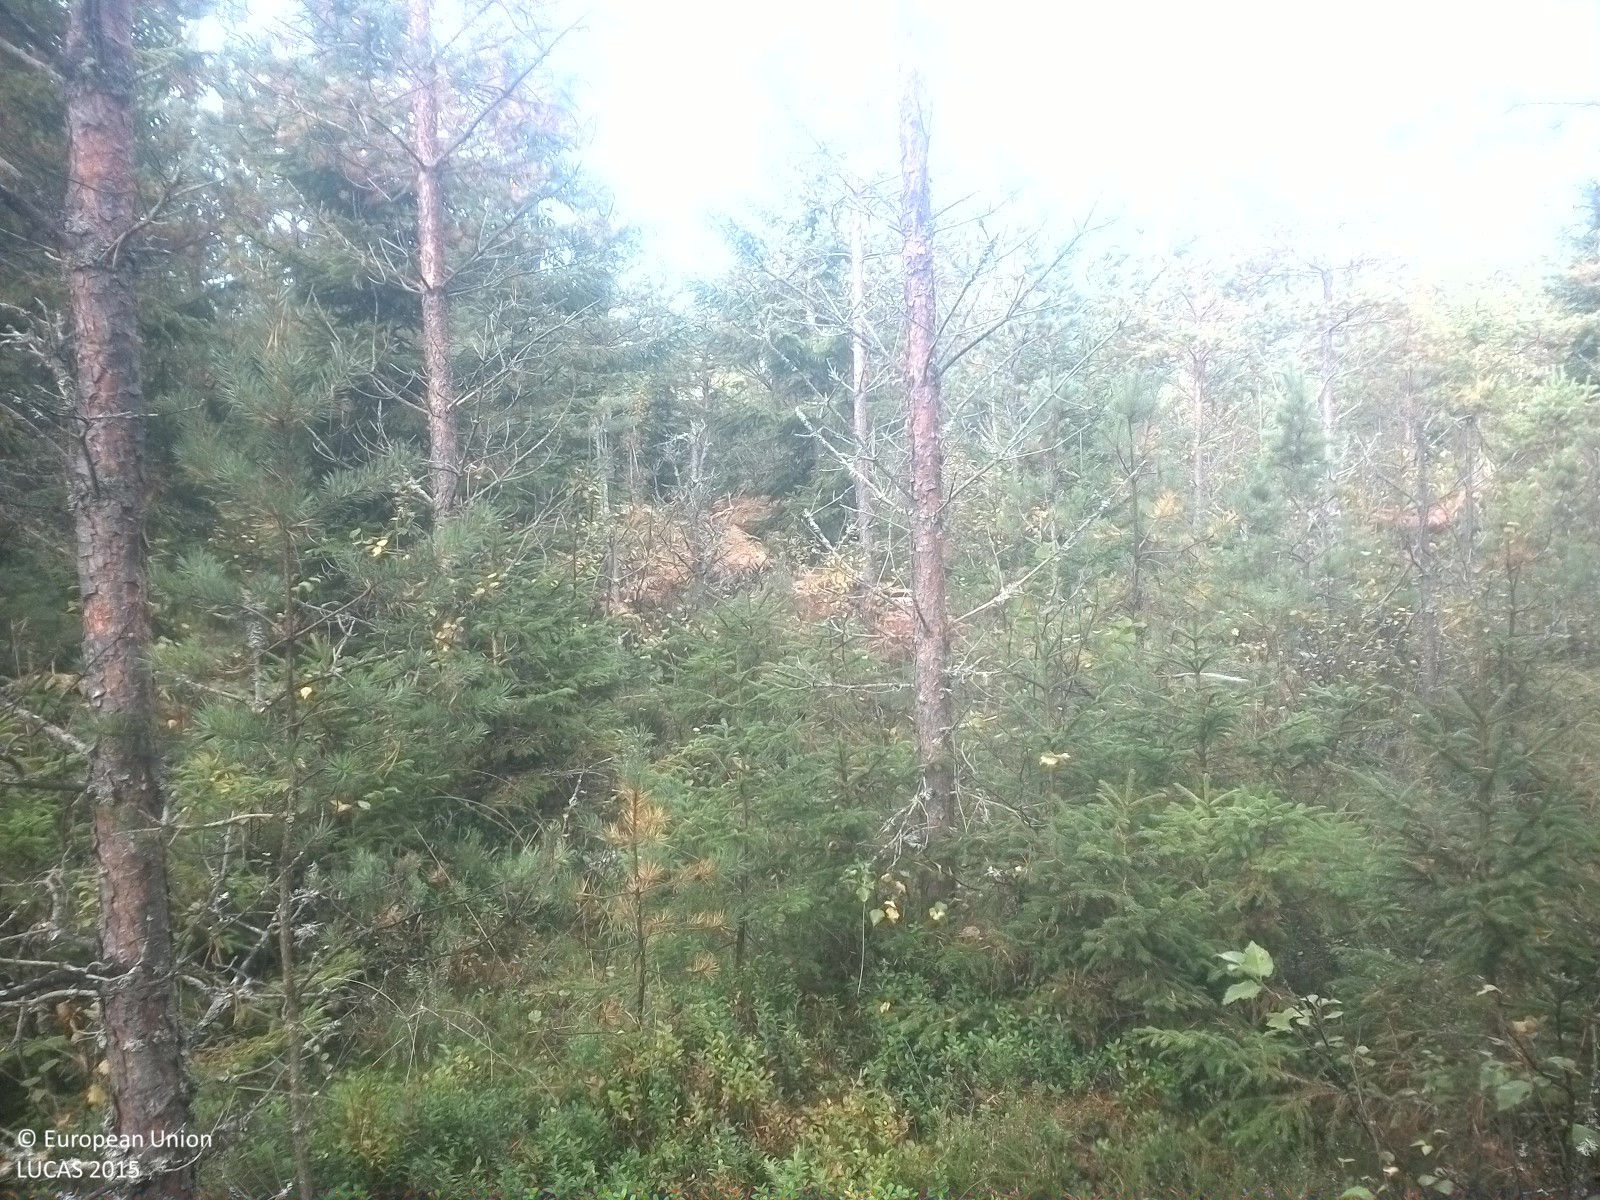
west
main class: Woodland
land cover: Pine dominated coniferous woodland
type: boreal forest
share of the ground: 25 - 50 %
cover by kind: coniferous forest trees 35 %, herbaceous plants 35 %, lichens and mosses 15 %, shrubs 10 %, broadleaved forest trees 5 %
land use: Forestry
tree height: < 5 m
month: September
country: SE
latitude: 58.8593
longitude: 15.6277
